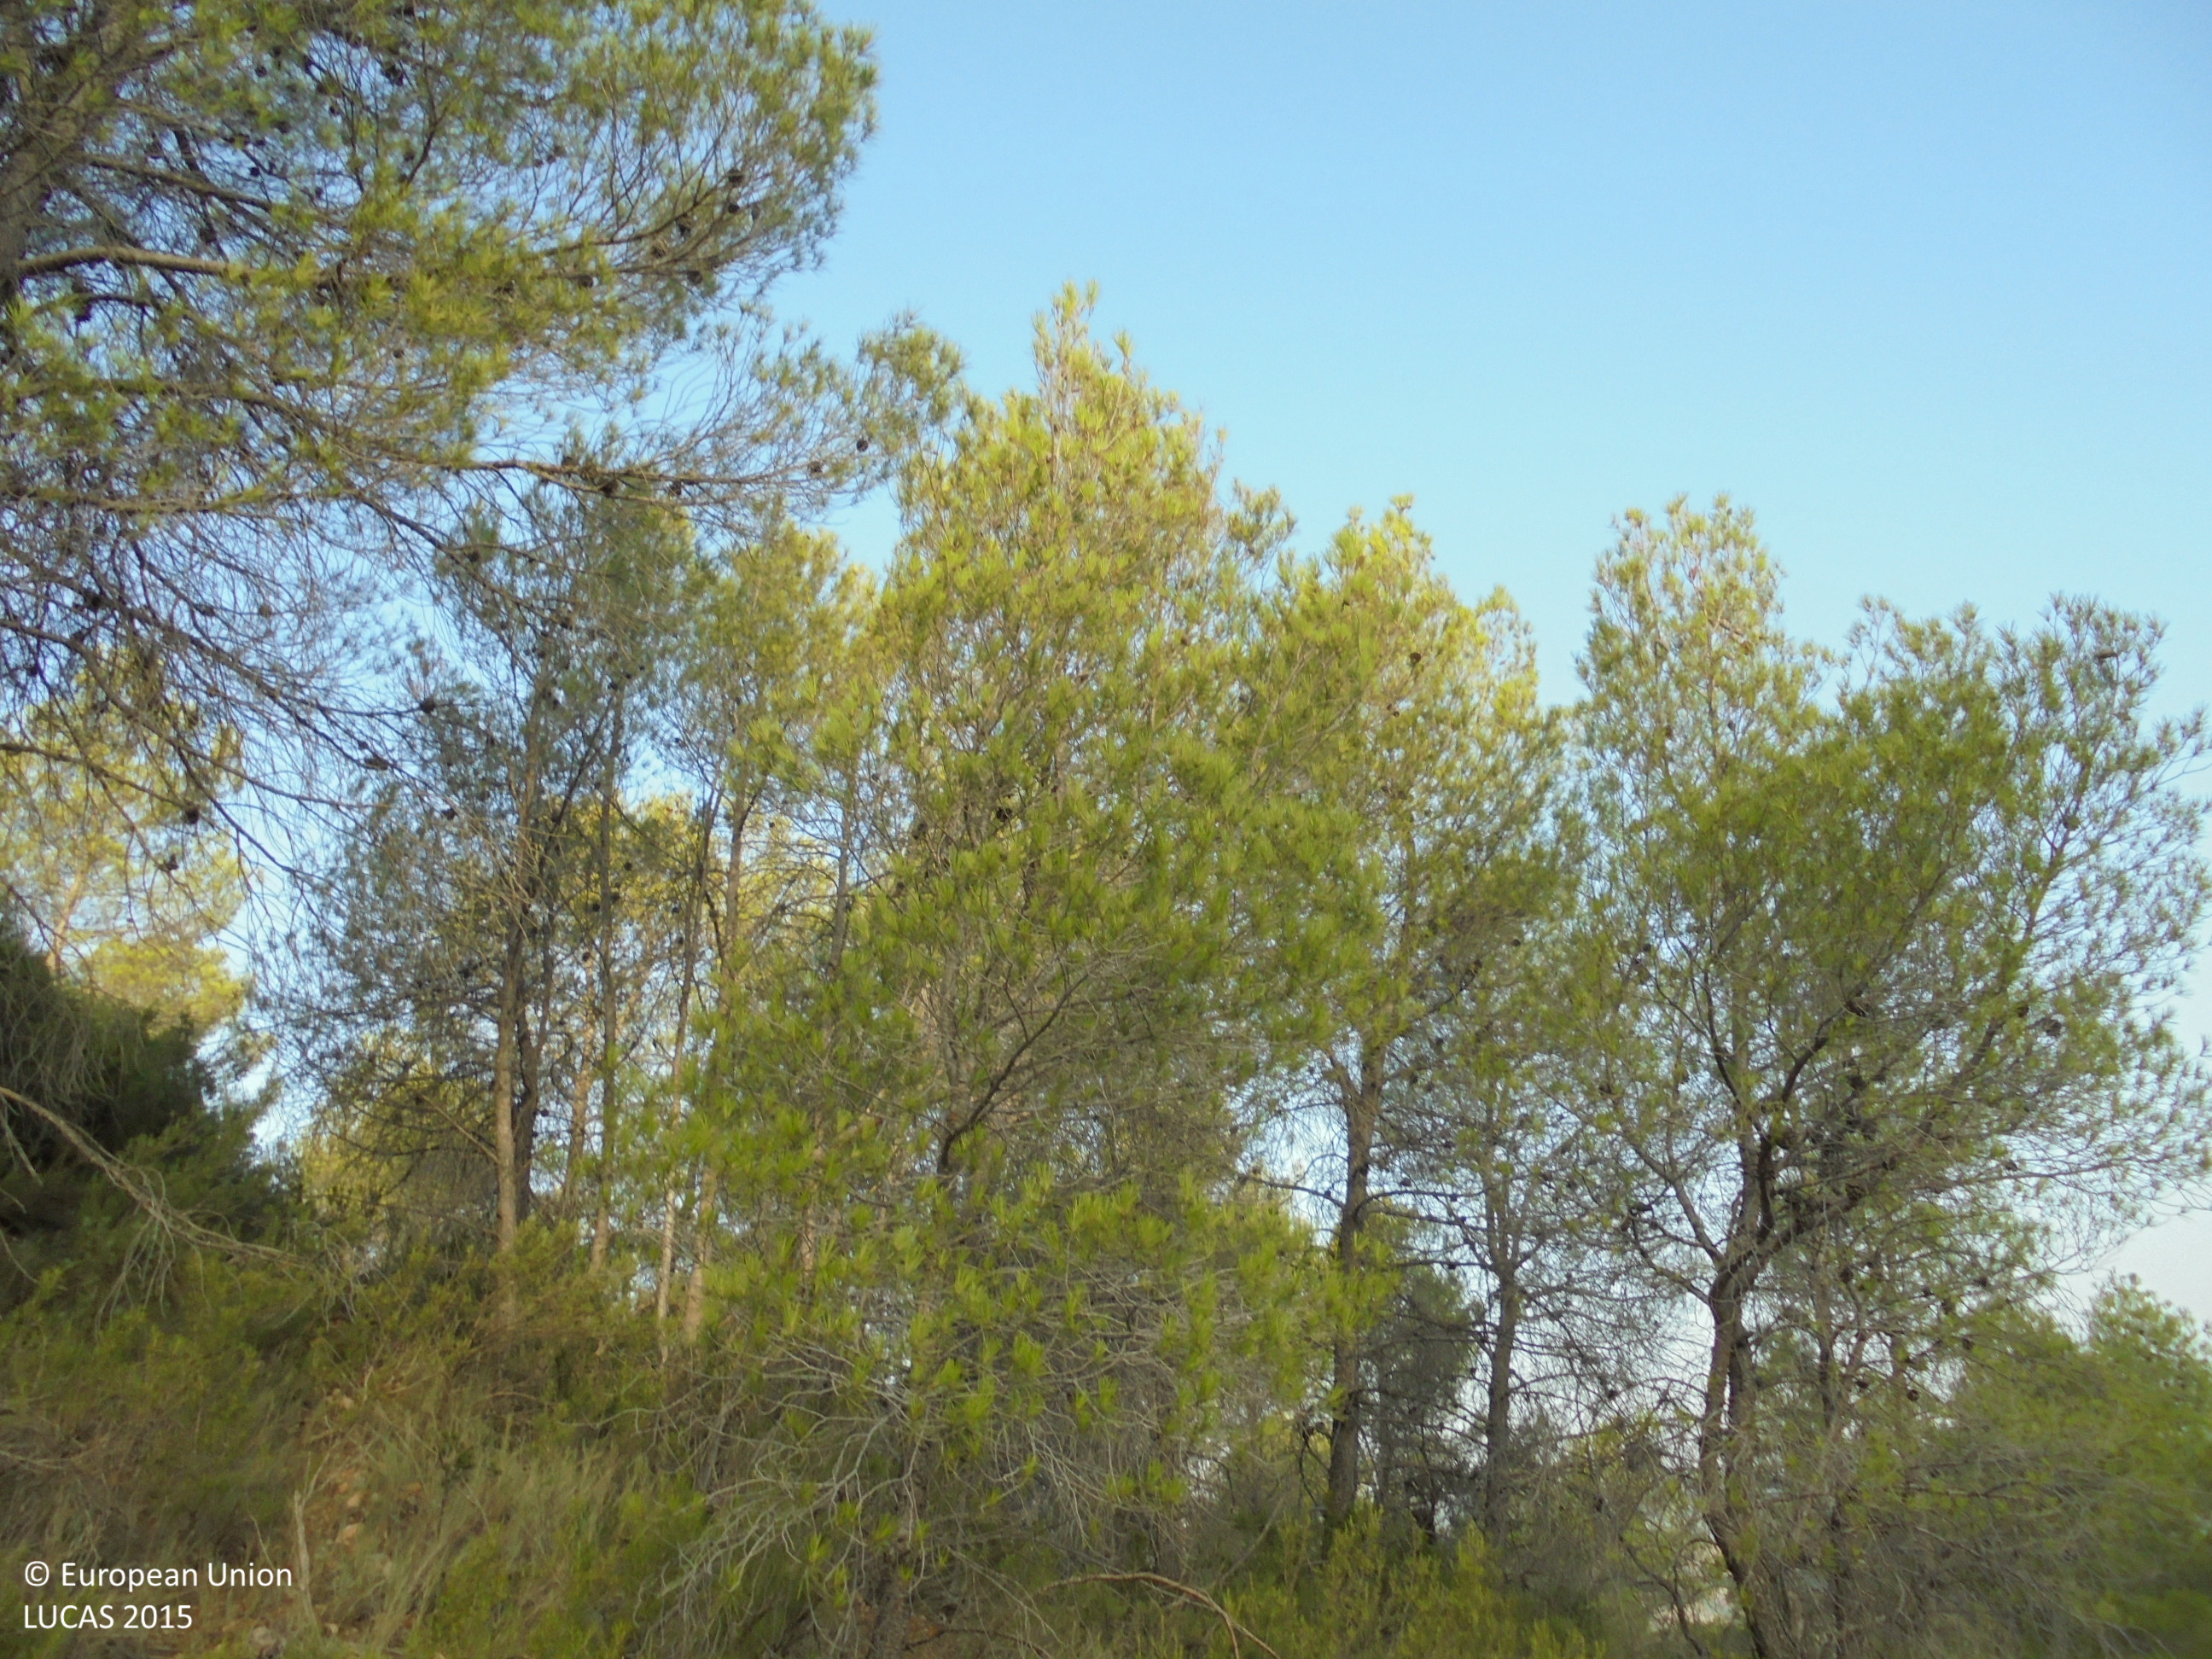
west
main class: Woodland
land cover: Pine dominated coniferous woodland
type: coniferous forest of the mediterranean region
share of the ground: 50 - 75 %
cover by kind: coniferous forest trees 70 %, shrubs 20 %, unconsolidated bare surface 10 %
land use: Semi-natural and natural areas not in use
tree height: > 5 m
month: August
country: ES
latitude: 39.1154
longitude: -1.0185
